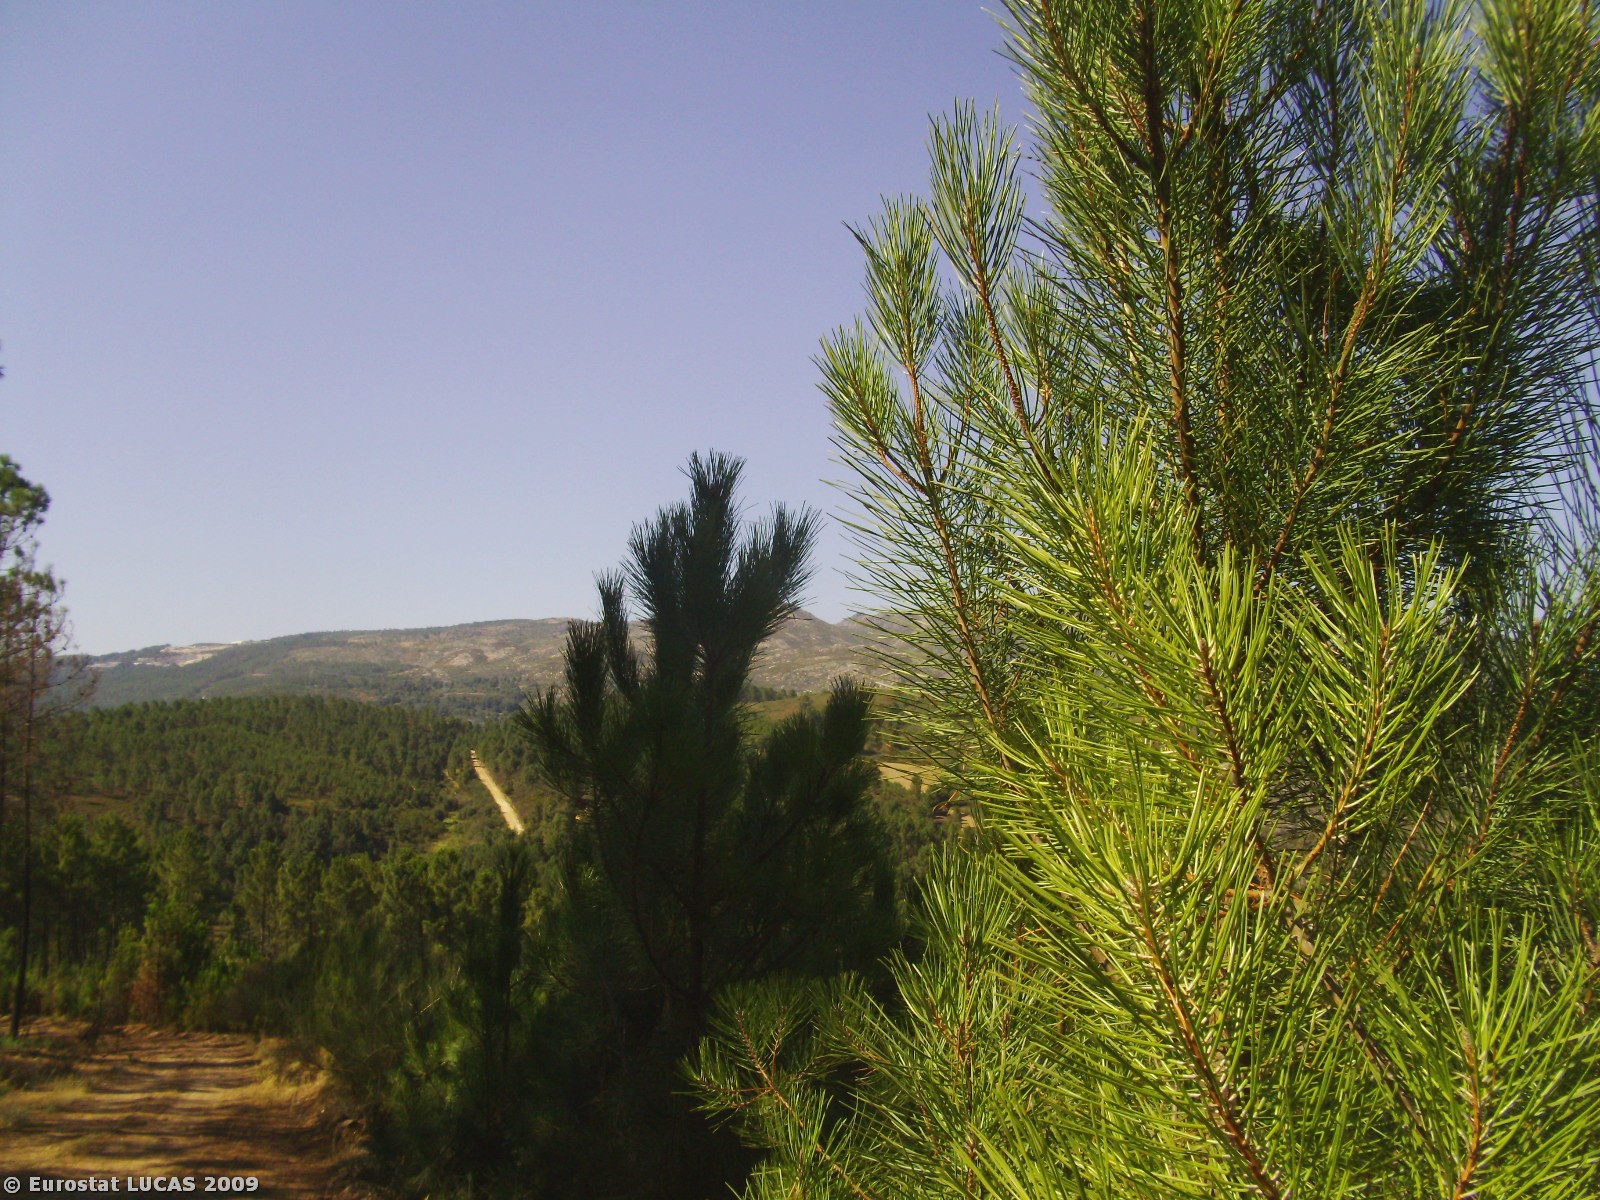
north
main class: Woodland
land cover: Coniferous woodland
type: coniferous forest of the mediterranean region
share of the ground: > 75 %
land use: Forestry
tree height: > 5 m
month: August
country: PT
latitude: 41.6820
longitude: -7.6369
